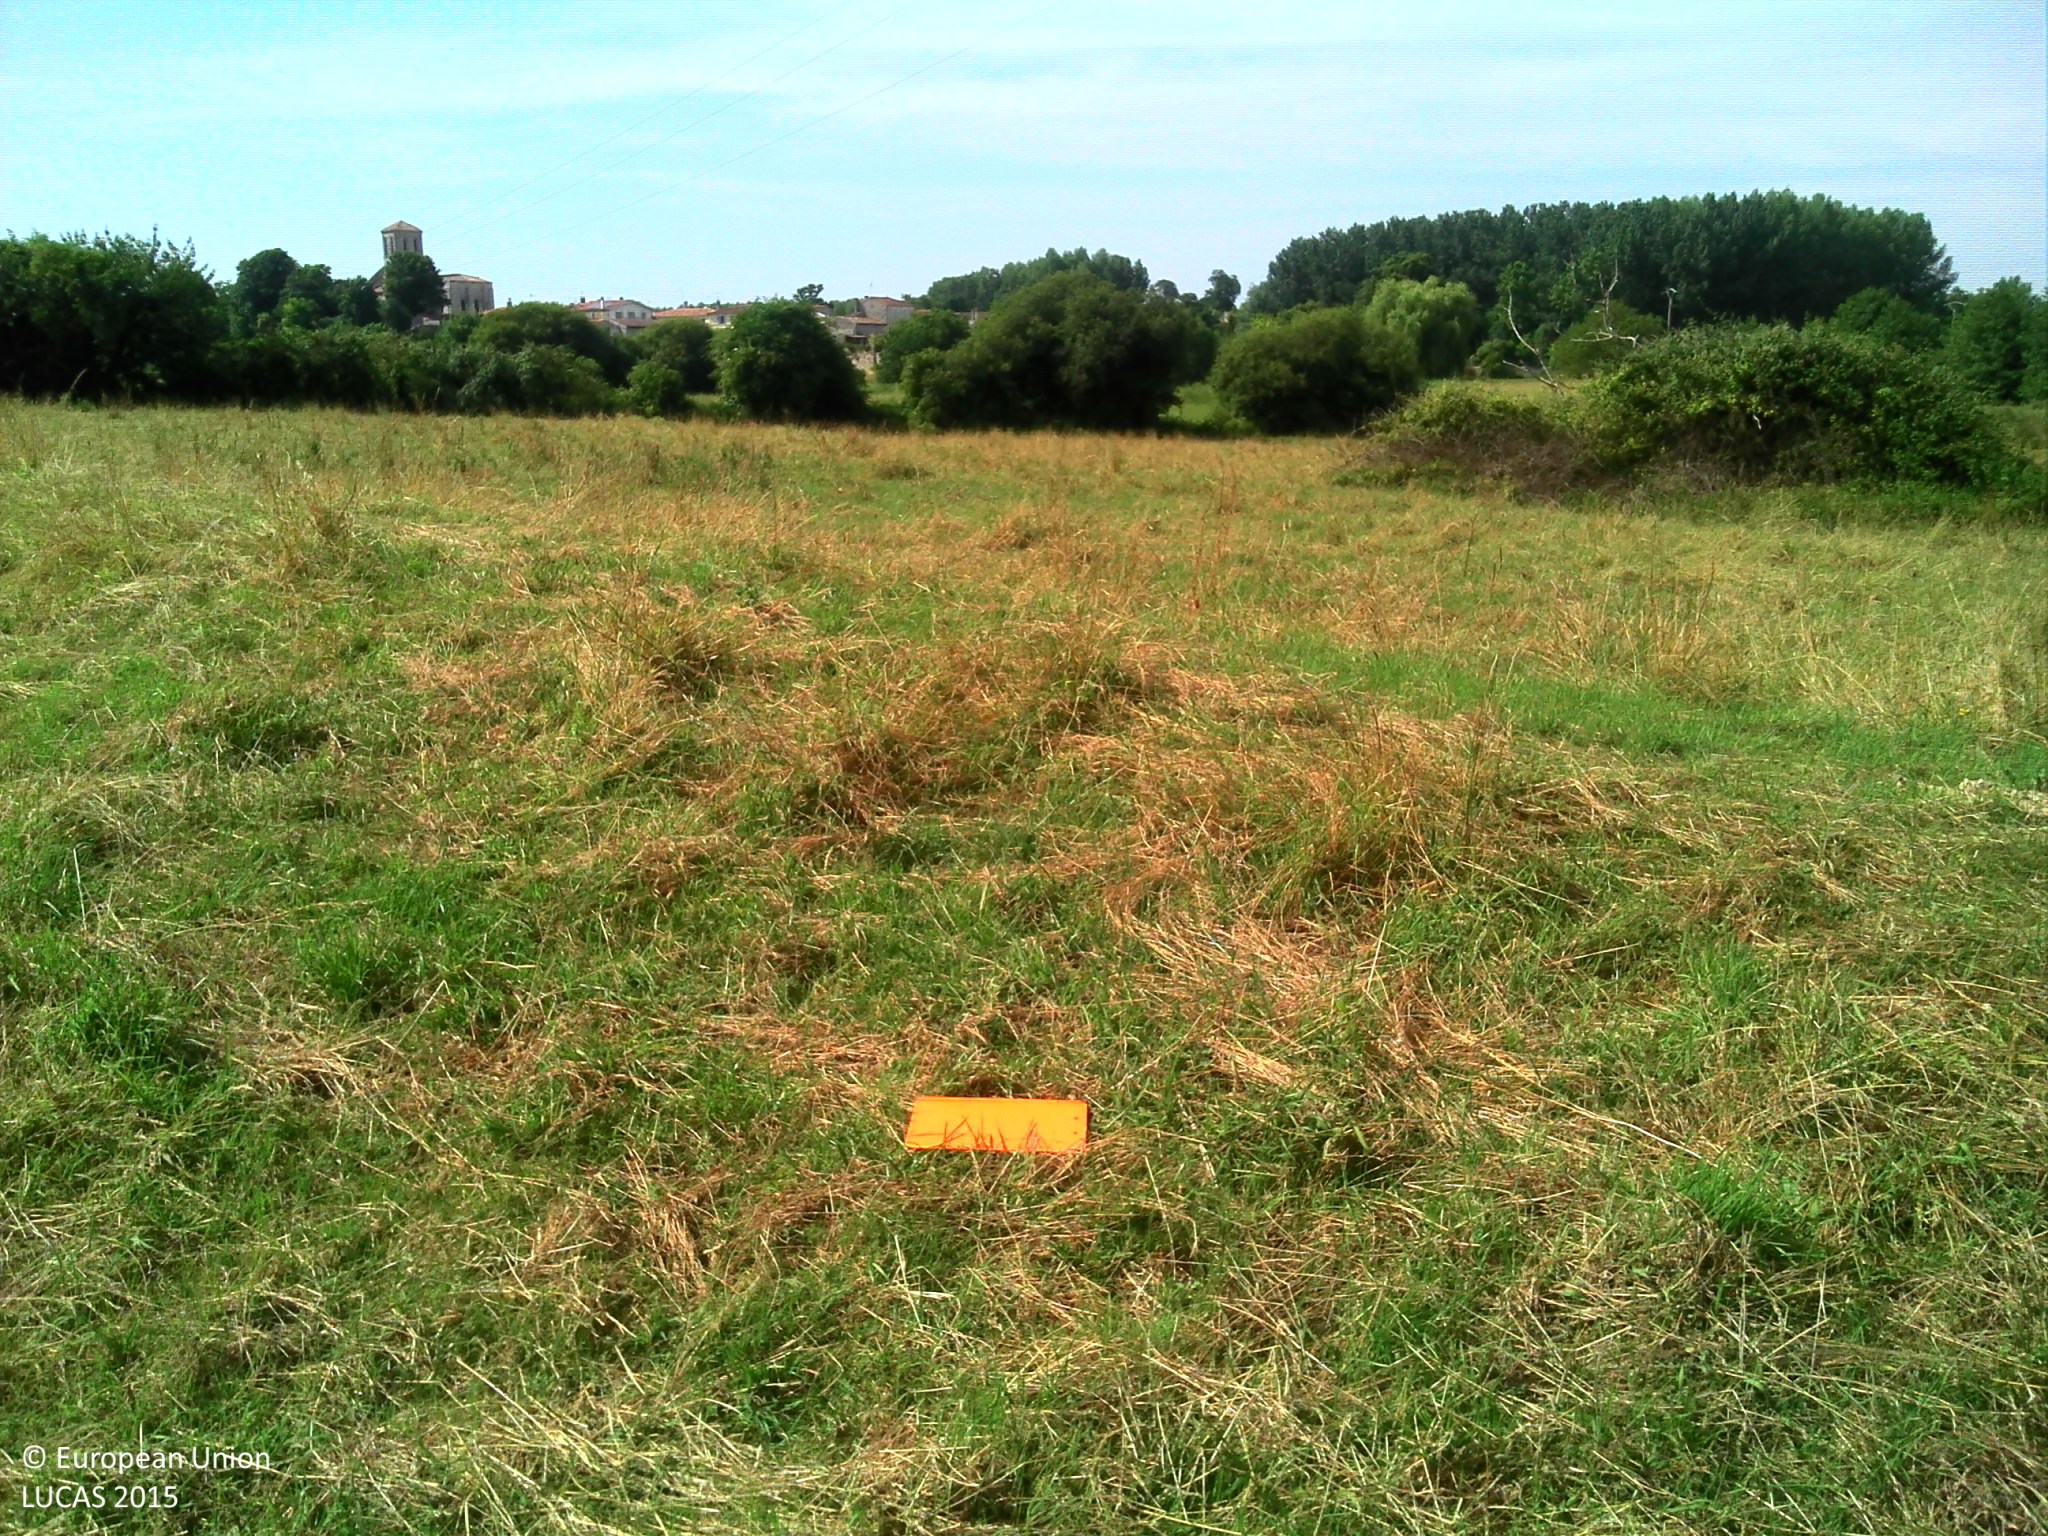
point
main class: Grassland
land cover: Grassland without tree/shrub cover
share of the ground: > 75 %
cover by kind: herbaceous plants 100 %
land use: Agriculture (excluding fallow land and kitchen gardens)
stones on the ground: < 10 %
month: June
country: FR
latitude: 45.8283
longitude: -0.9048
